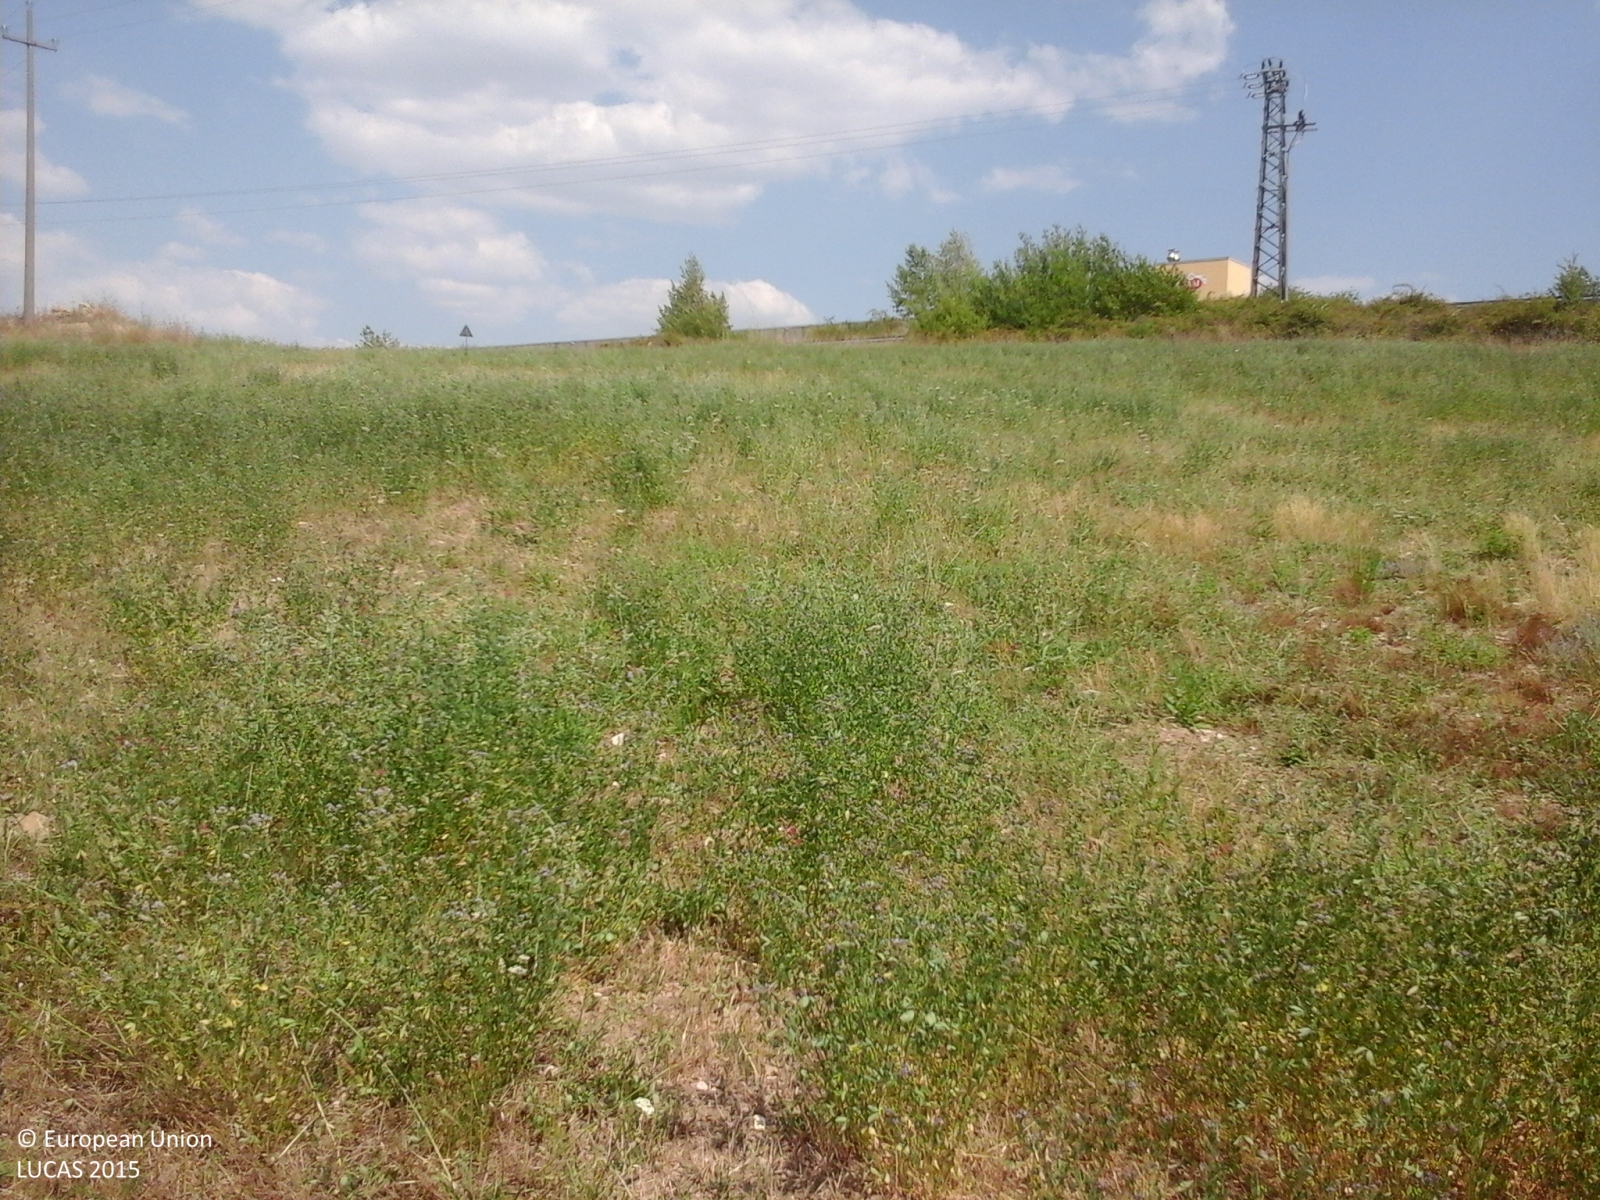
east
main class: Cropland
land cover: Lucerne
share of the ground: > 75 %
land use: Agriculture (excluding fallow land and kitchen gardens)
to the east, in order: Abandoned hedges; Lucerne; Electric lines; Lucerne; Abandoned hedges; Electric lines; Paved roads, cycling and walking lanes; Ditches and canals; Grass margins; Shrubland with sparse tree cover; Artificial constructions in urban areas
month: July
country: IT
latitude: 40.8757
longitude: 15.1418
